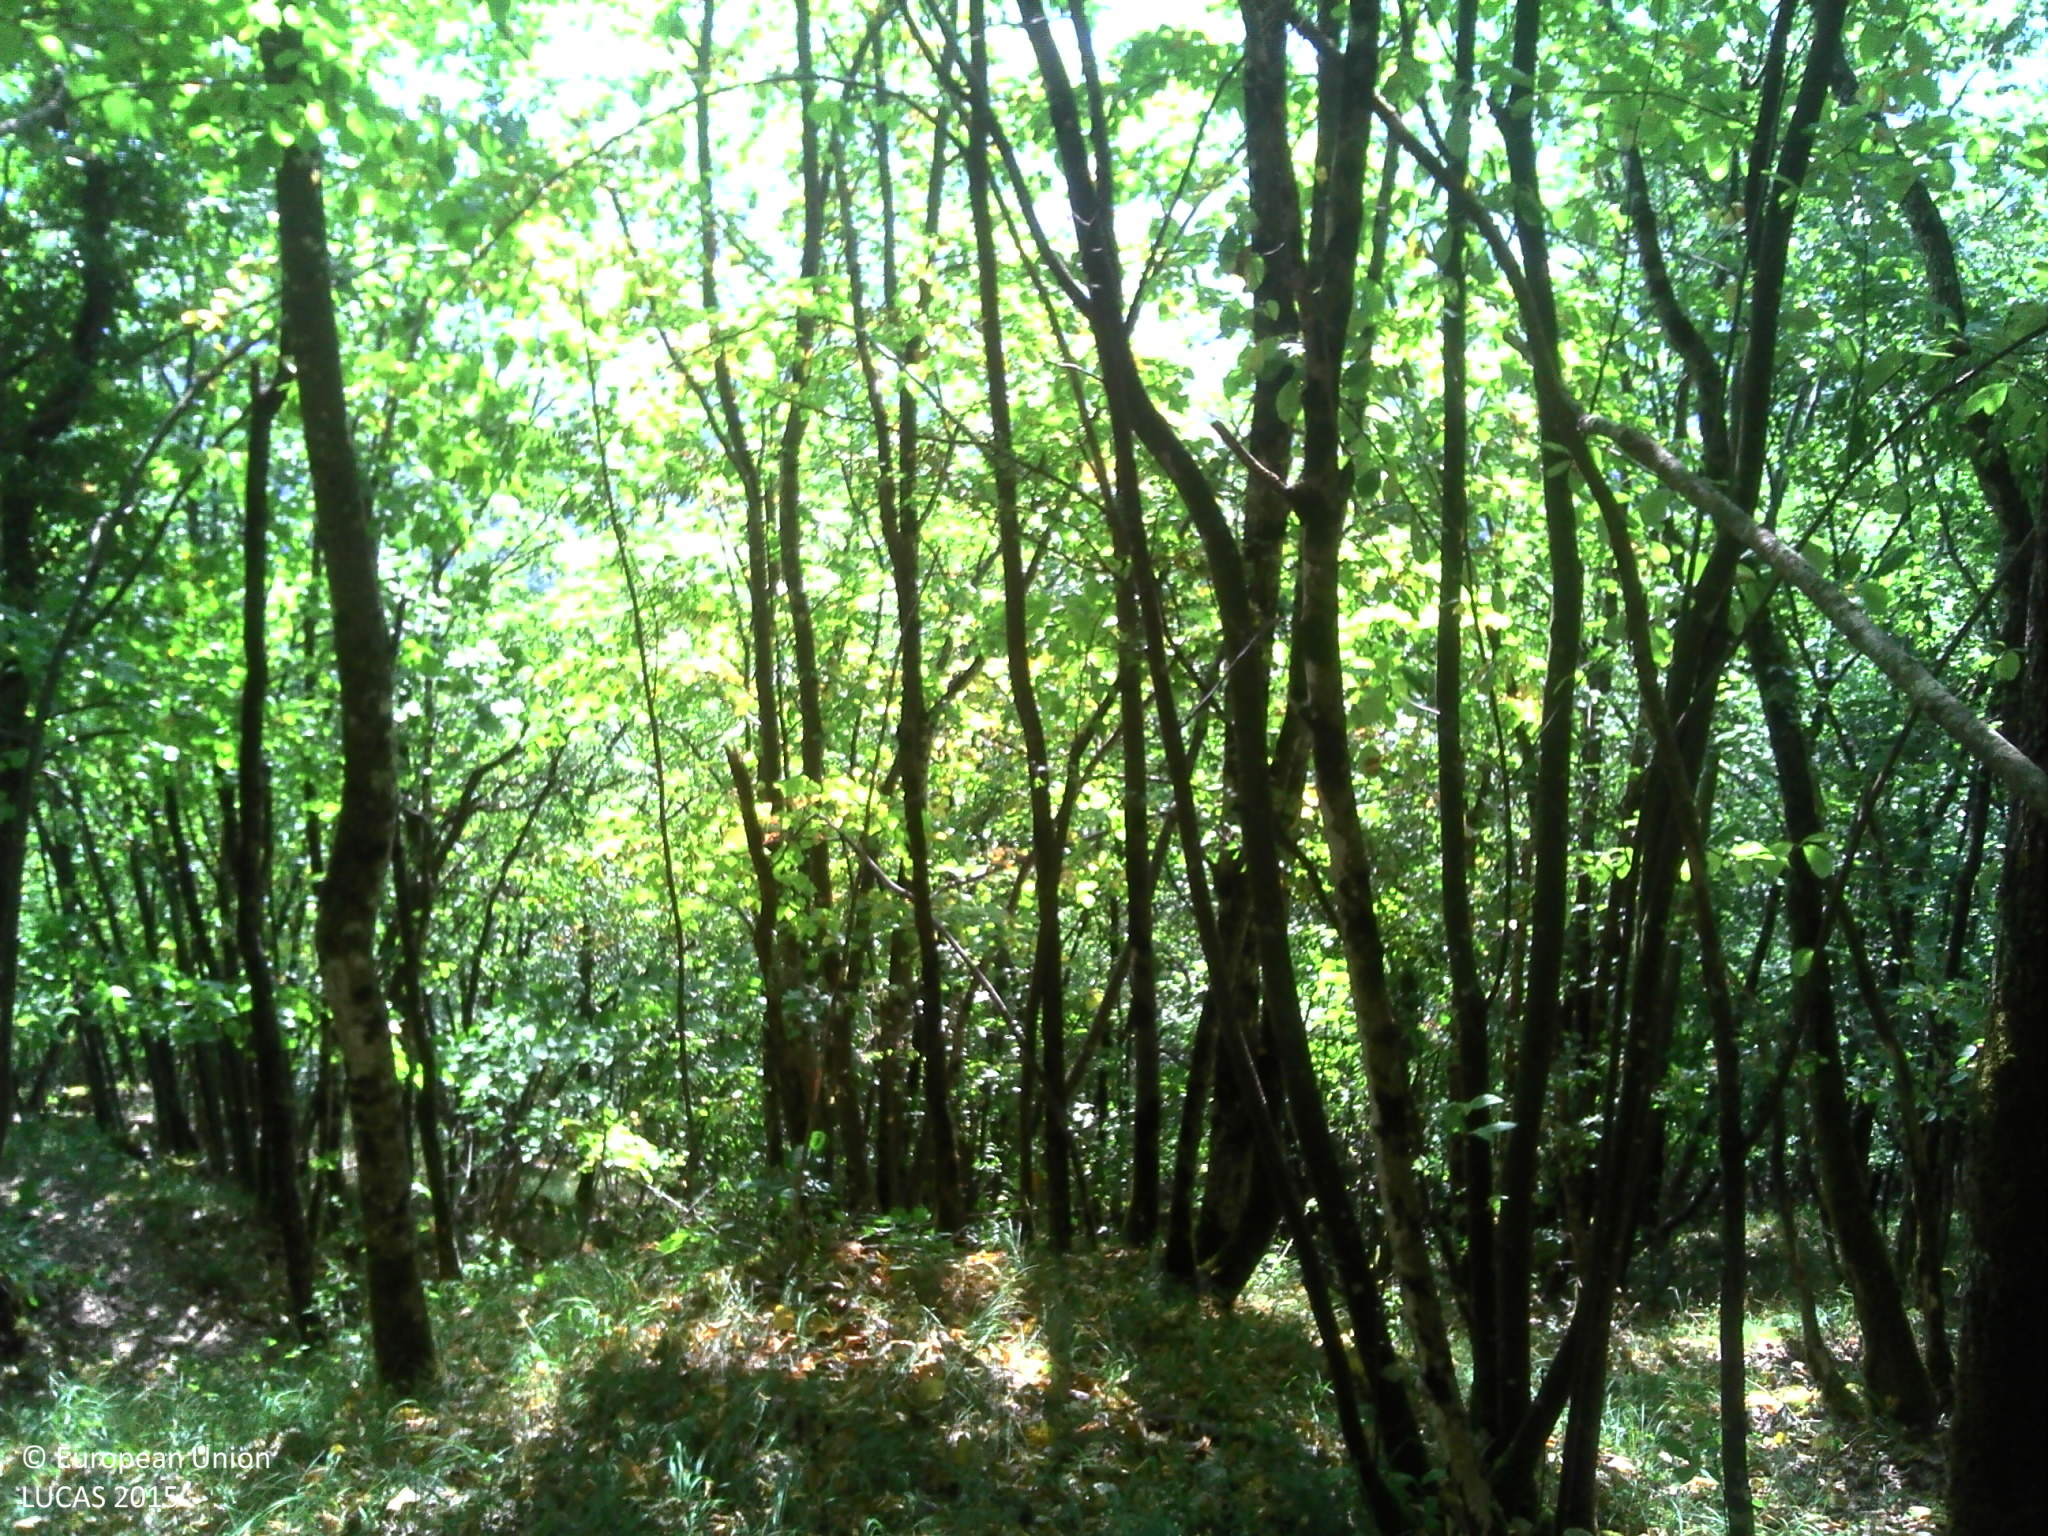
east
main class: Woodland
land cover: Broadleaved woodland
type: beech forest
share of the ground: > 75 %
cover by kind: broadleaved forest trees 90 %, herbaceous plants 5 %, unconsolidated bare surface 5 %
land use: Forestry
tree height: > 5 m
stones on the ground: 10 - 25 %
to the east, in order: Broadleaved woodland; Tracks; Broadleaved woodland; Tracks; Broadleaved woodland
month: July
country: FR
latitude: 45.8303
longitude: 6.1293
